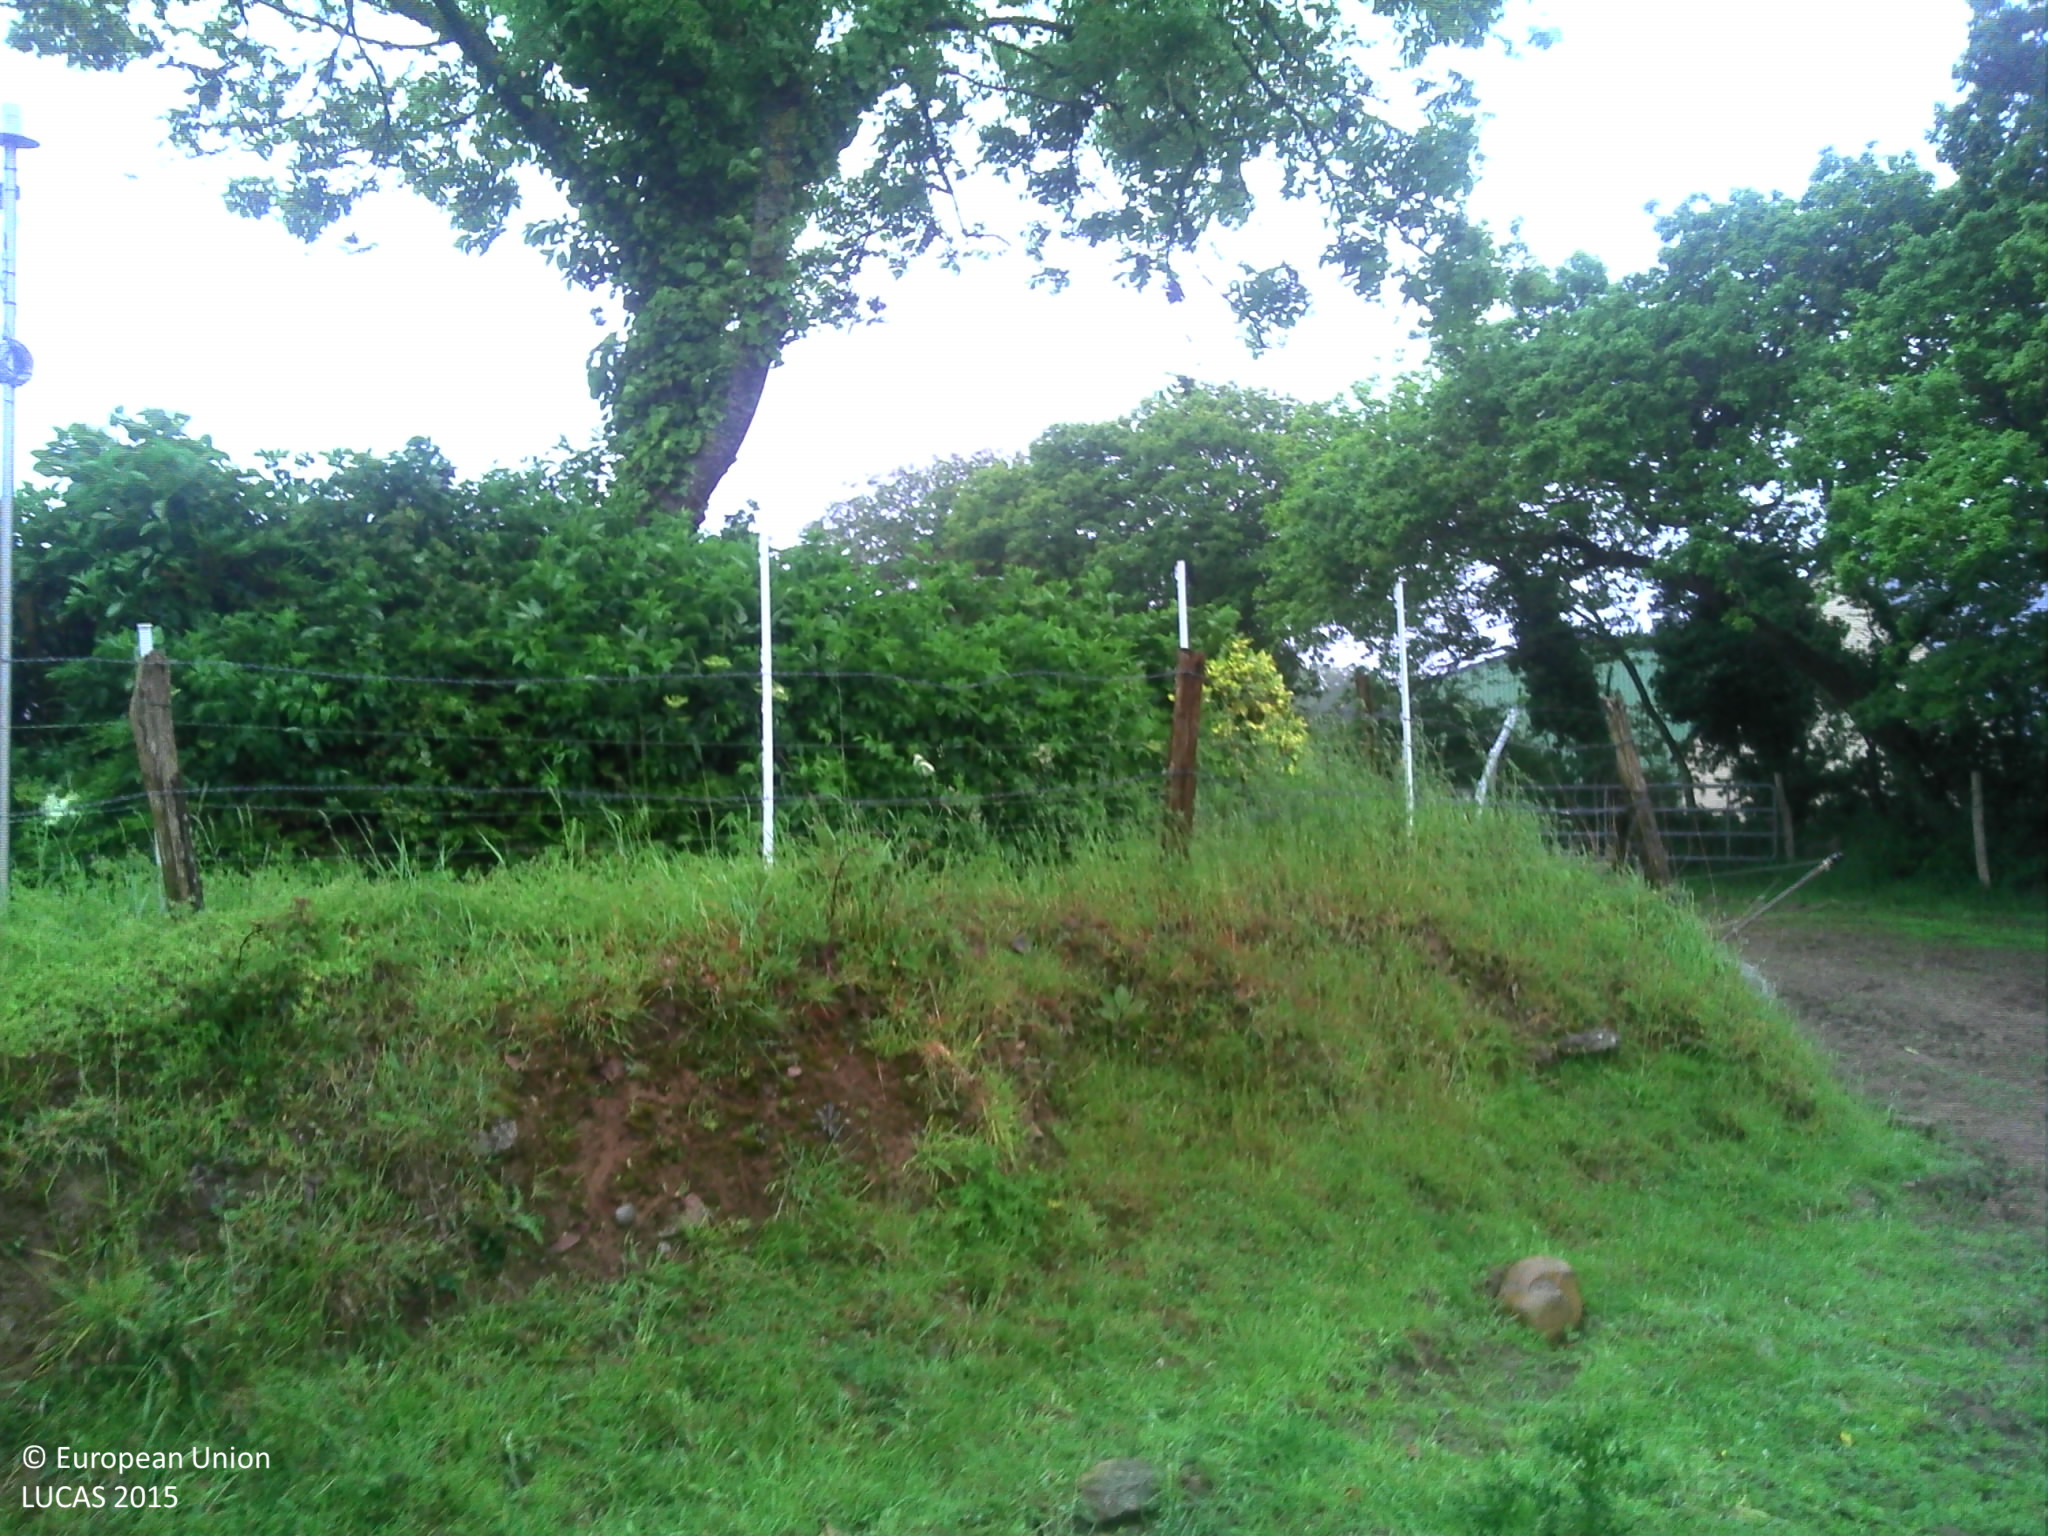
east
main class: Grassland
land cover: Grassland without tree/shrub cover
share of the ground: > 75 %
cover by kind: herbaceous plants 95 %, shrubs 5 %
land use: Agriculture (excluding fallow land and kitchen gardens)
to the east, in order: Grassland without tree/shrub cover; Fences; Managed hedges; Tracks; Fences; Broadleaved woodland; Other bare soil; Artificial constructions in urban areas; Ditches and canals; Artificial constructions in urban areas; Grass margins; Broadleaved woodland; Grassland without tree/shrub cover
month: June
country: FR
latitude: 49.6228
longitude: -1.8065
